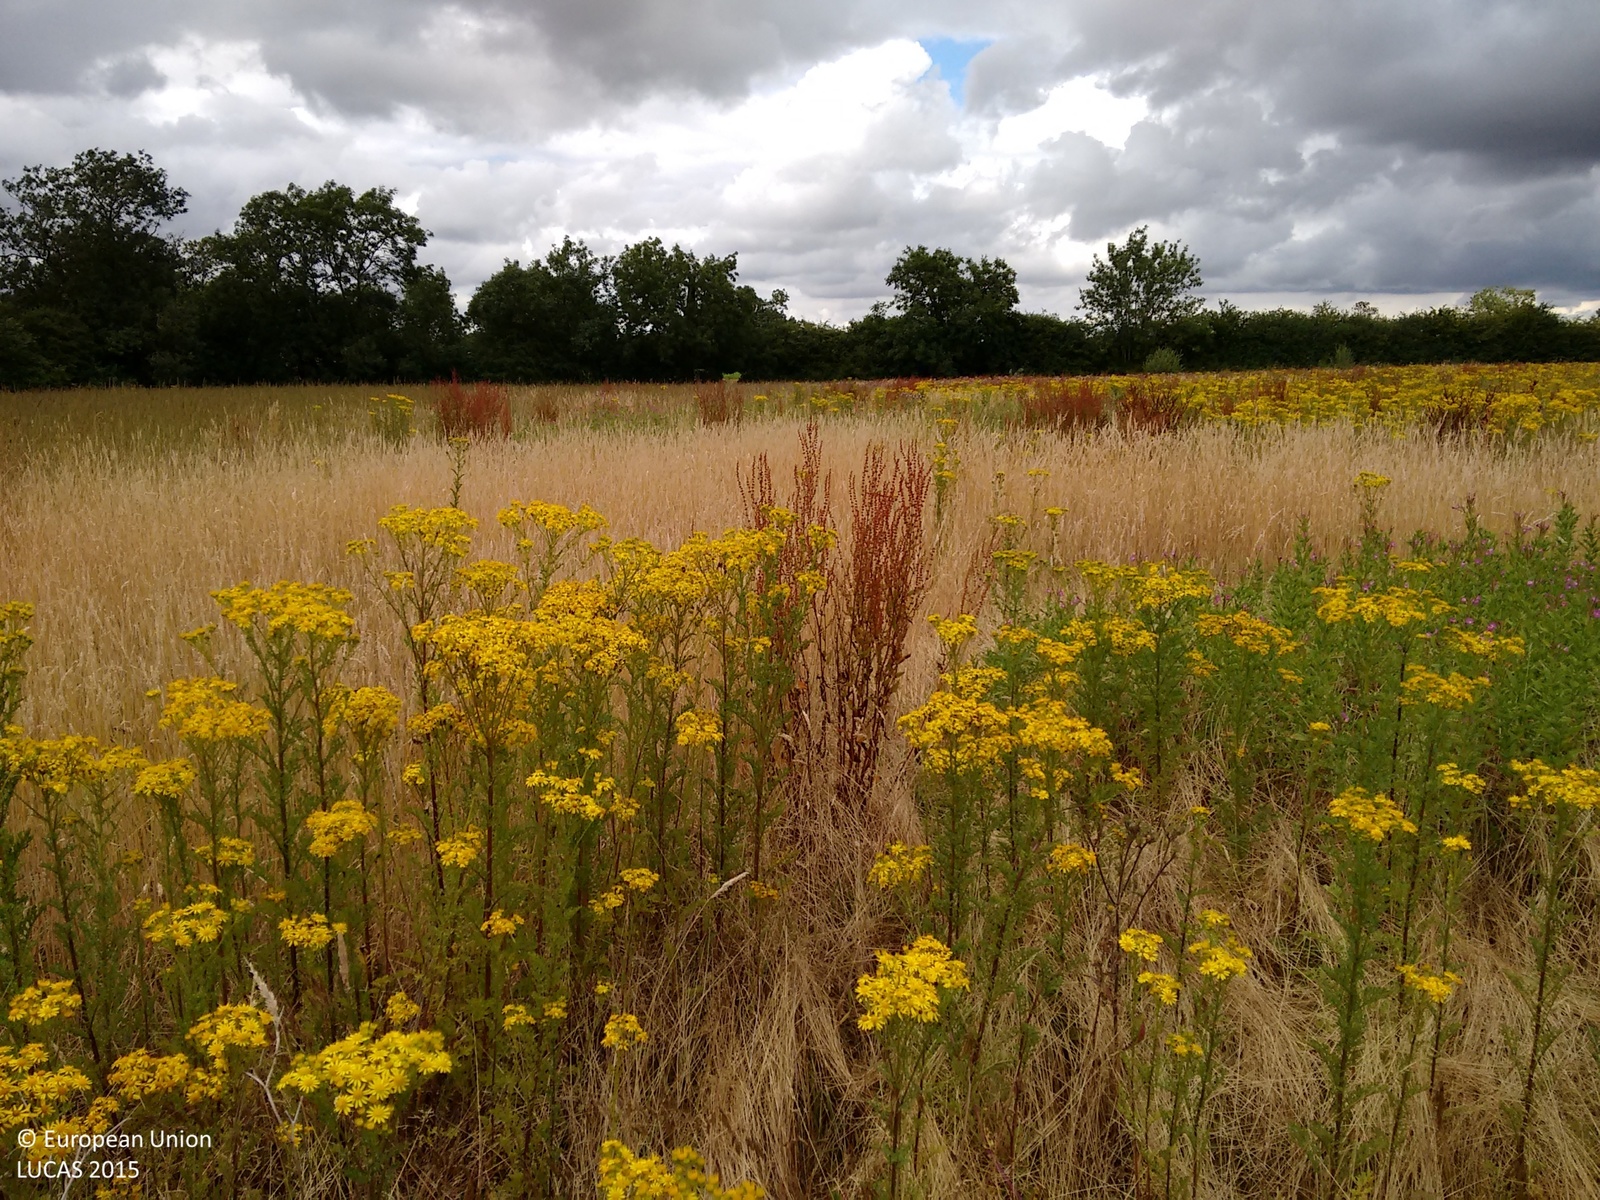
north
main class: Grassland
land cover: Spontaneously vegetated surfaces
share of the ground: > 75 %
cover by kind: herbaceous plants 100 %
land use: Fallow land
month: July
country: GB
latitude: 52.7884
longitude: -0.8218
